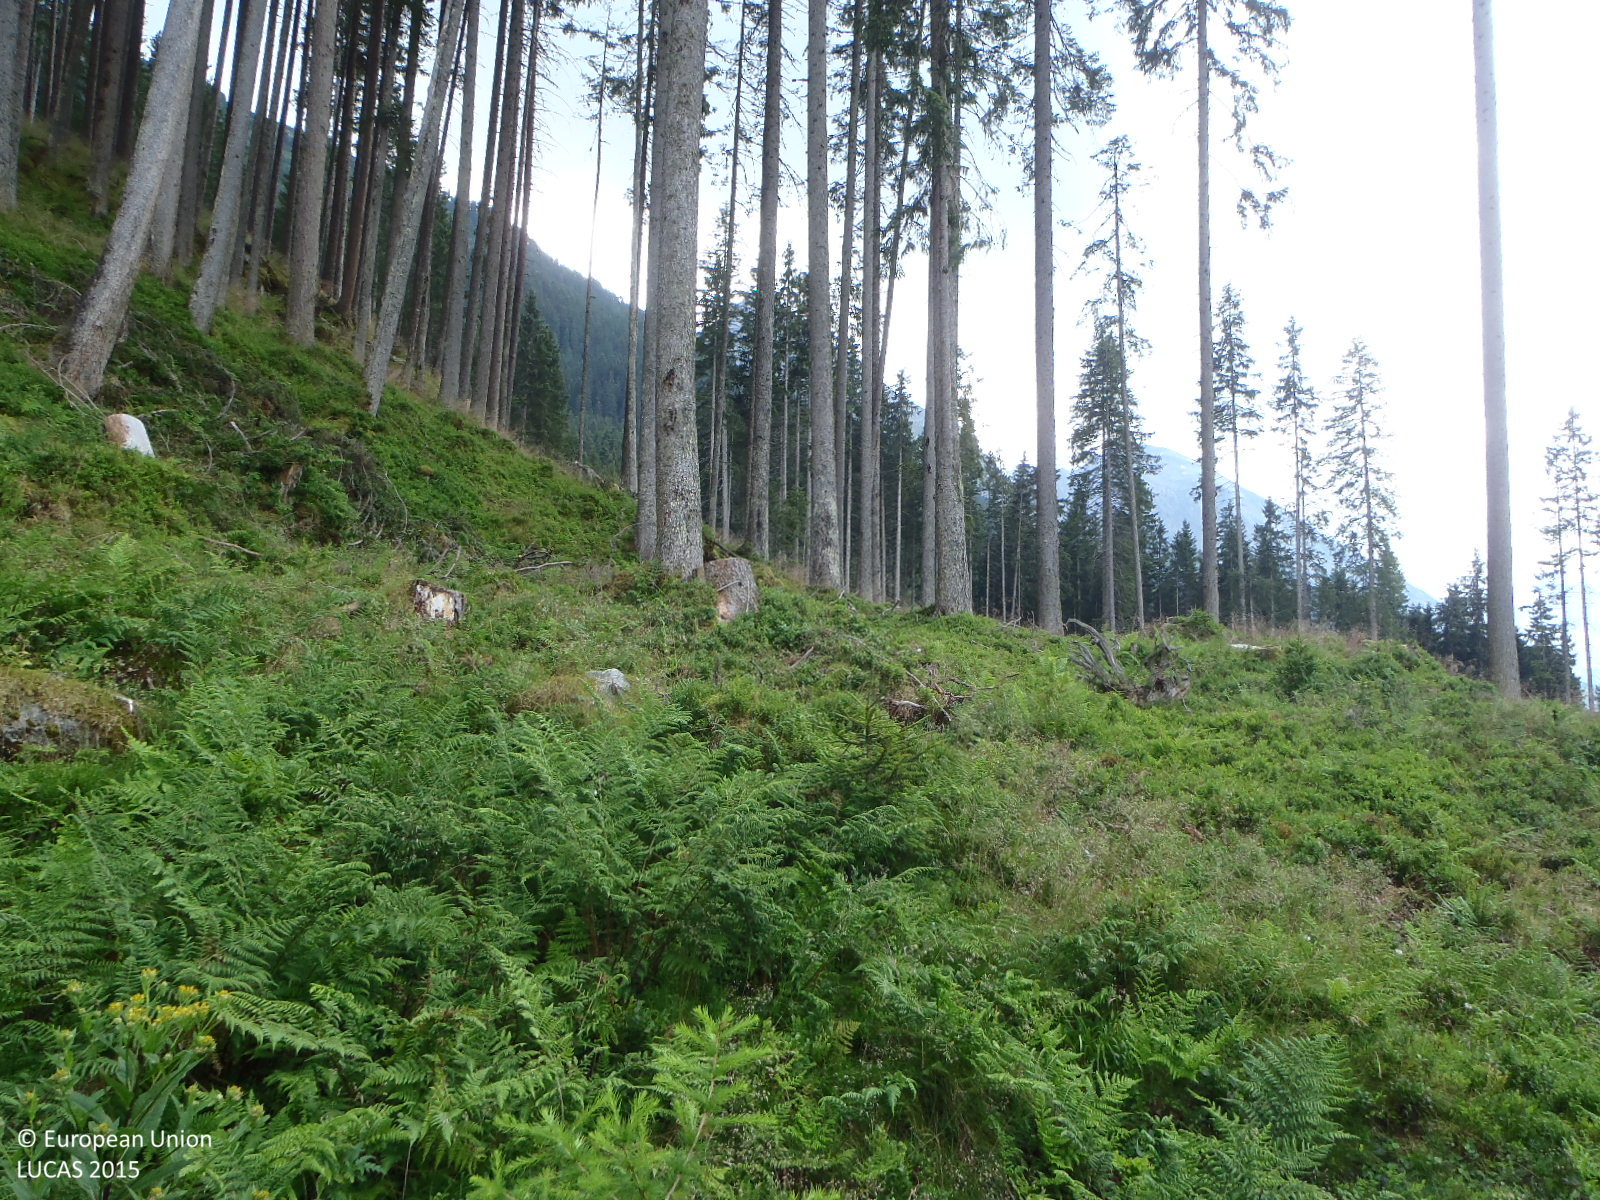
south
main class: Woodland
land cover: Spruce dominated coniferous woodland
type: alpine coniferous forest
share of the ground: 10 - 25 %
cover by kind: herbaceous plants 70 %, coniferous forest trees 25 %, shrubs 5 %
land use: Forestry
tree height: < 5 m
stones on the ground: < 10 %
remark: Clear cut
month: July
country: AT
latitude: 47.1478
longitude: 11.7260
